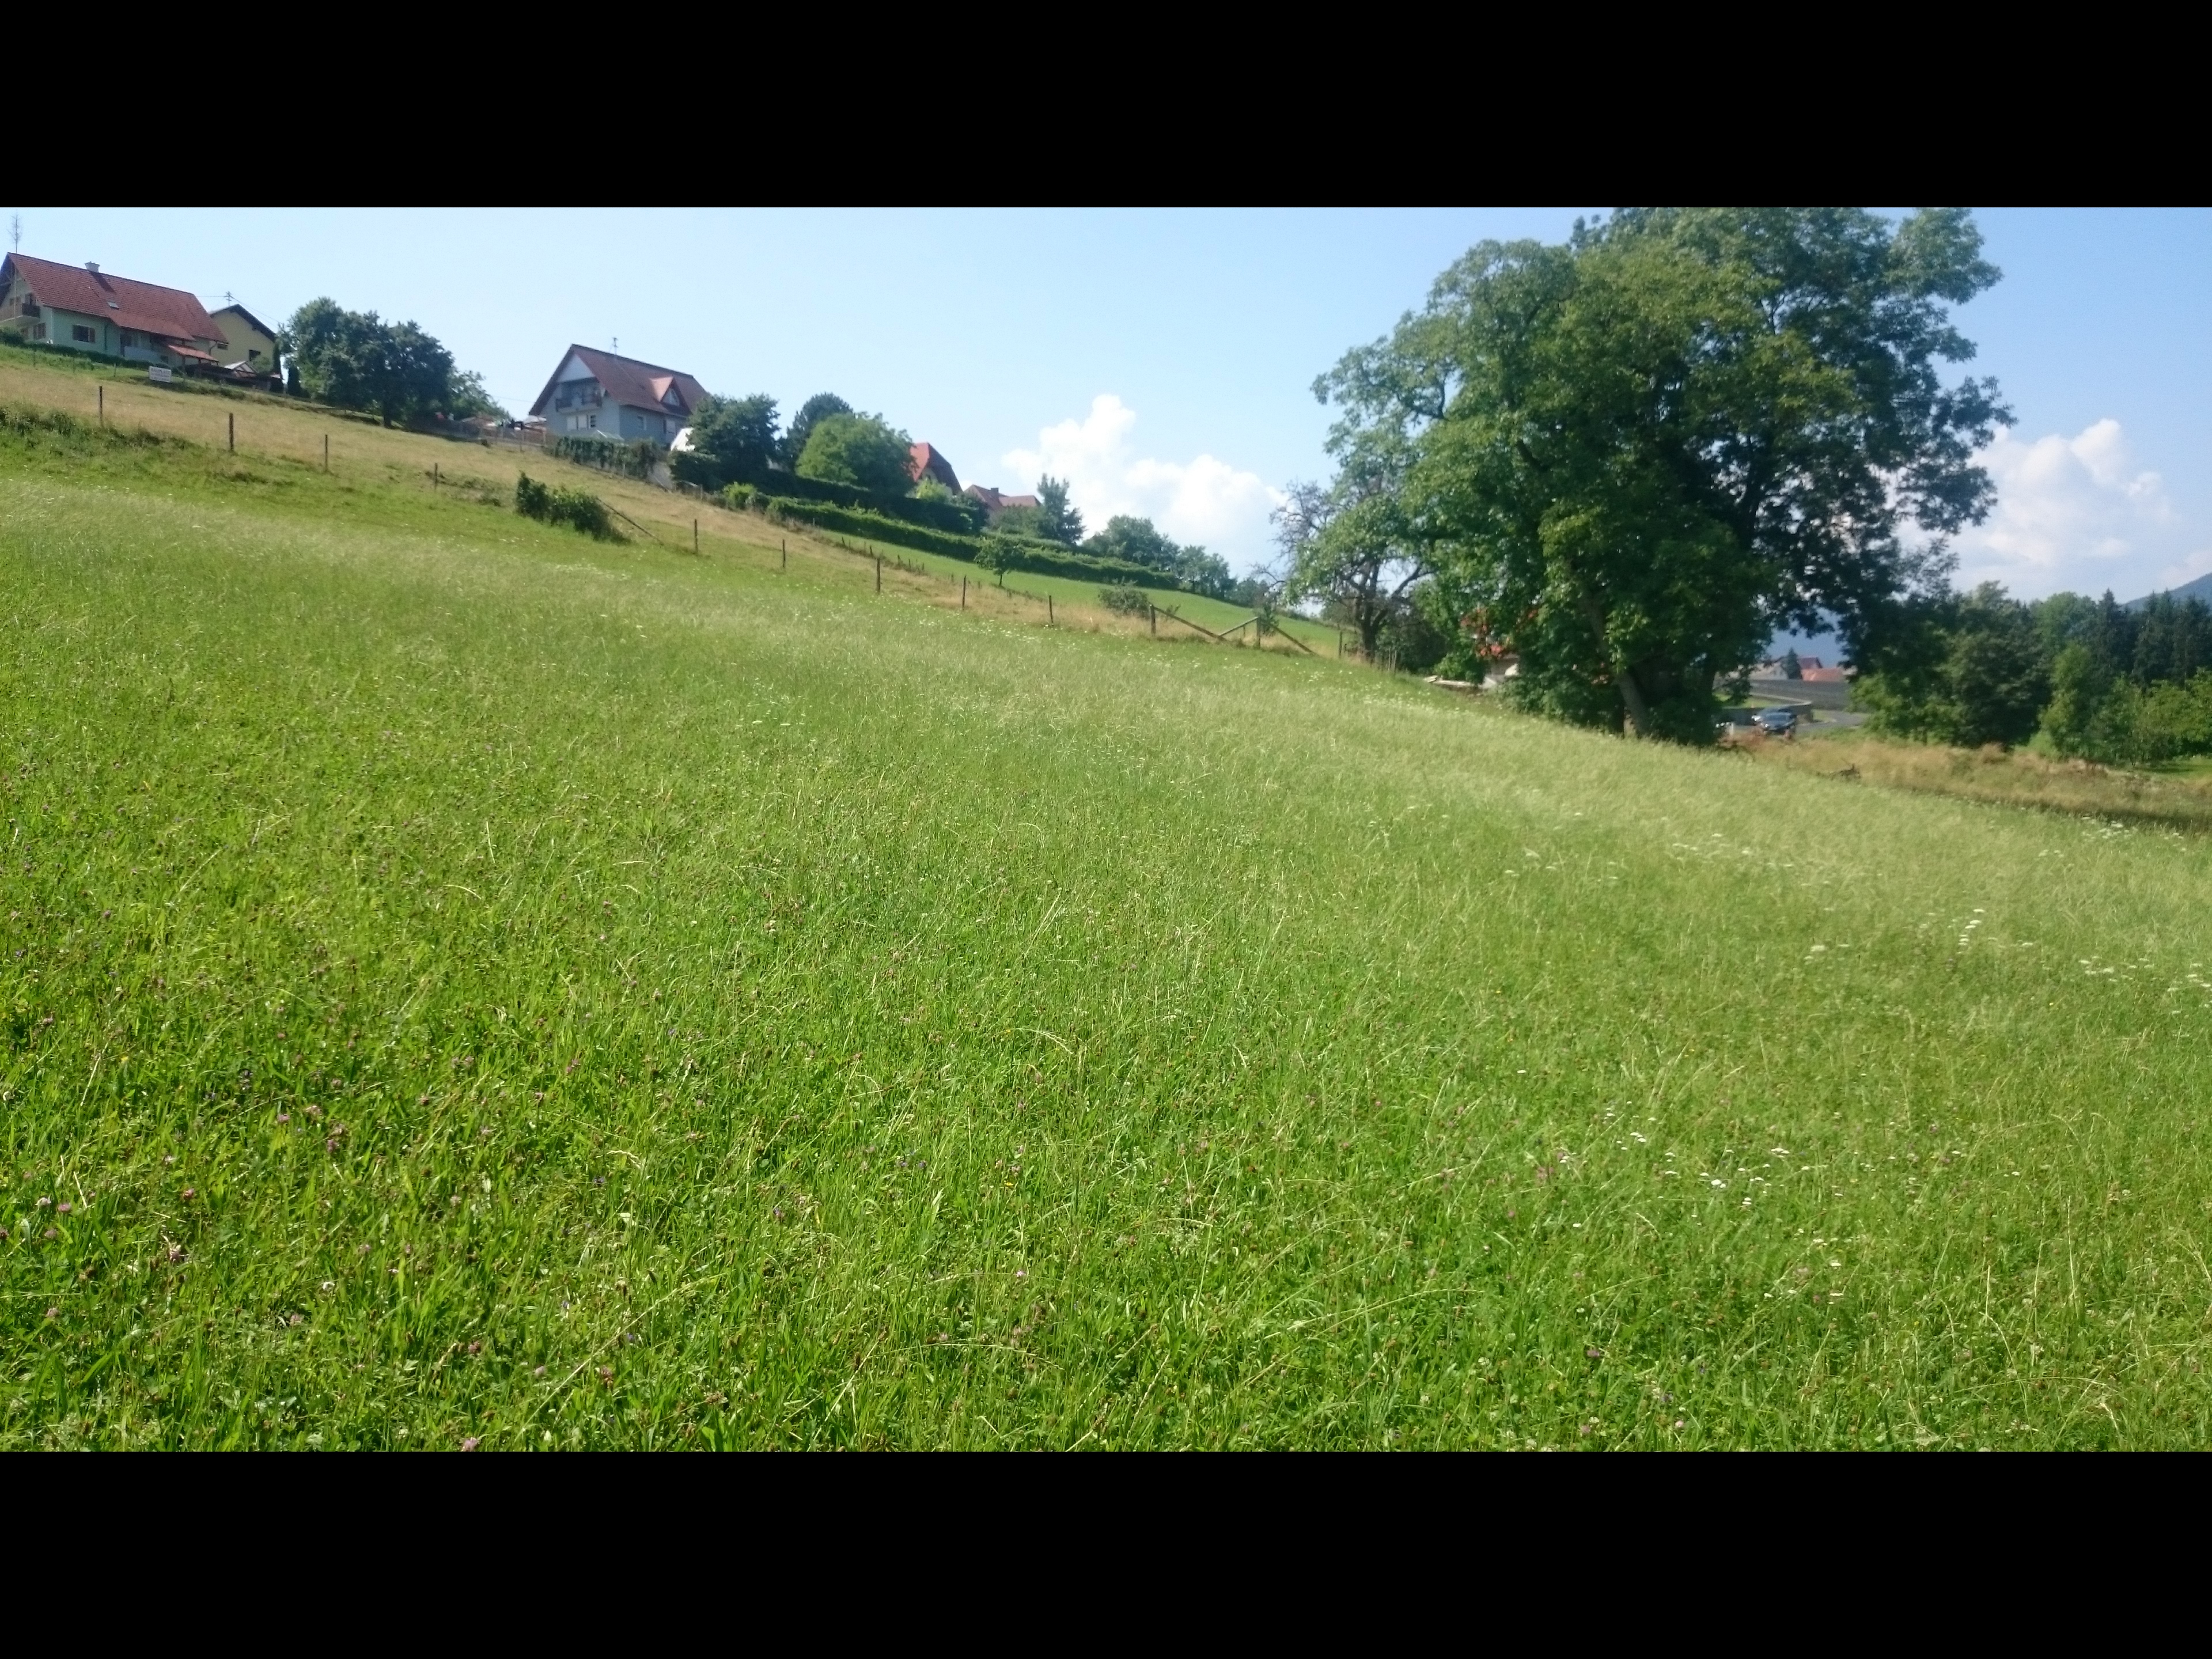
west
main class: Grassland
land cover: Grassland without tree/shrub cover
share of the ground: > 75 %
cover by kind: herbaceous plants 95 %, unconsolidated bare surface 5 %
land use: Agriculture (excluding fallow land and kitchen gardens)
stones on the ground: < 10 %
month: July
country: AT
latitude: 47.1967
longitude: 15.6103
